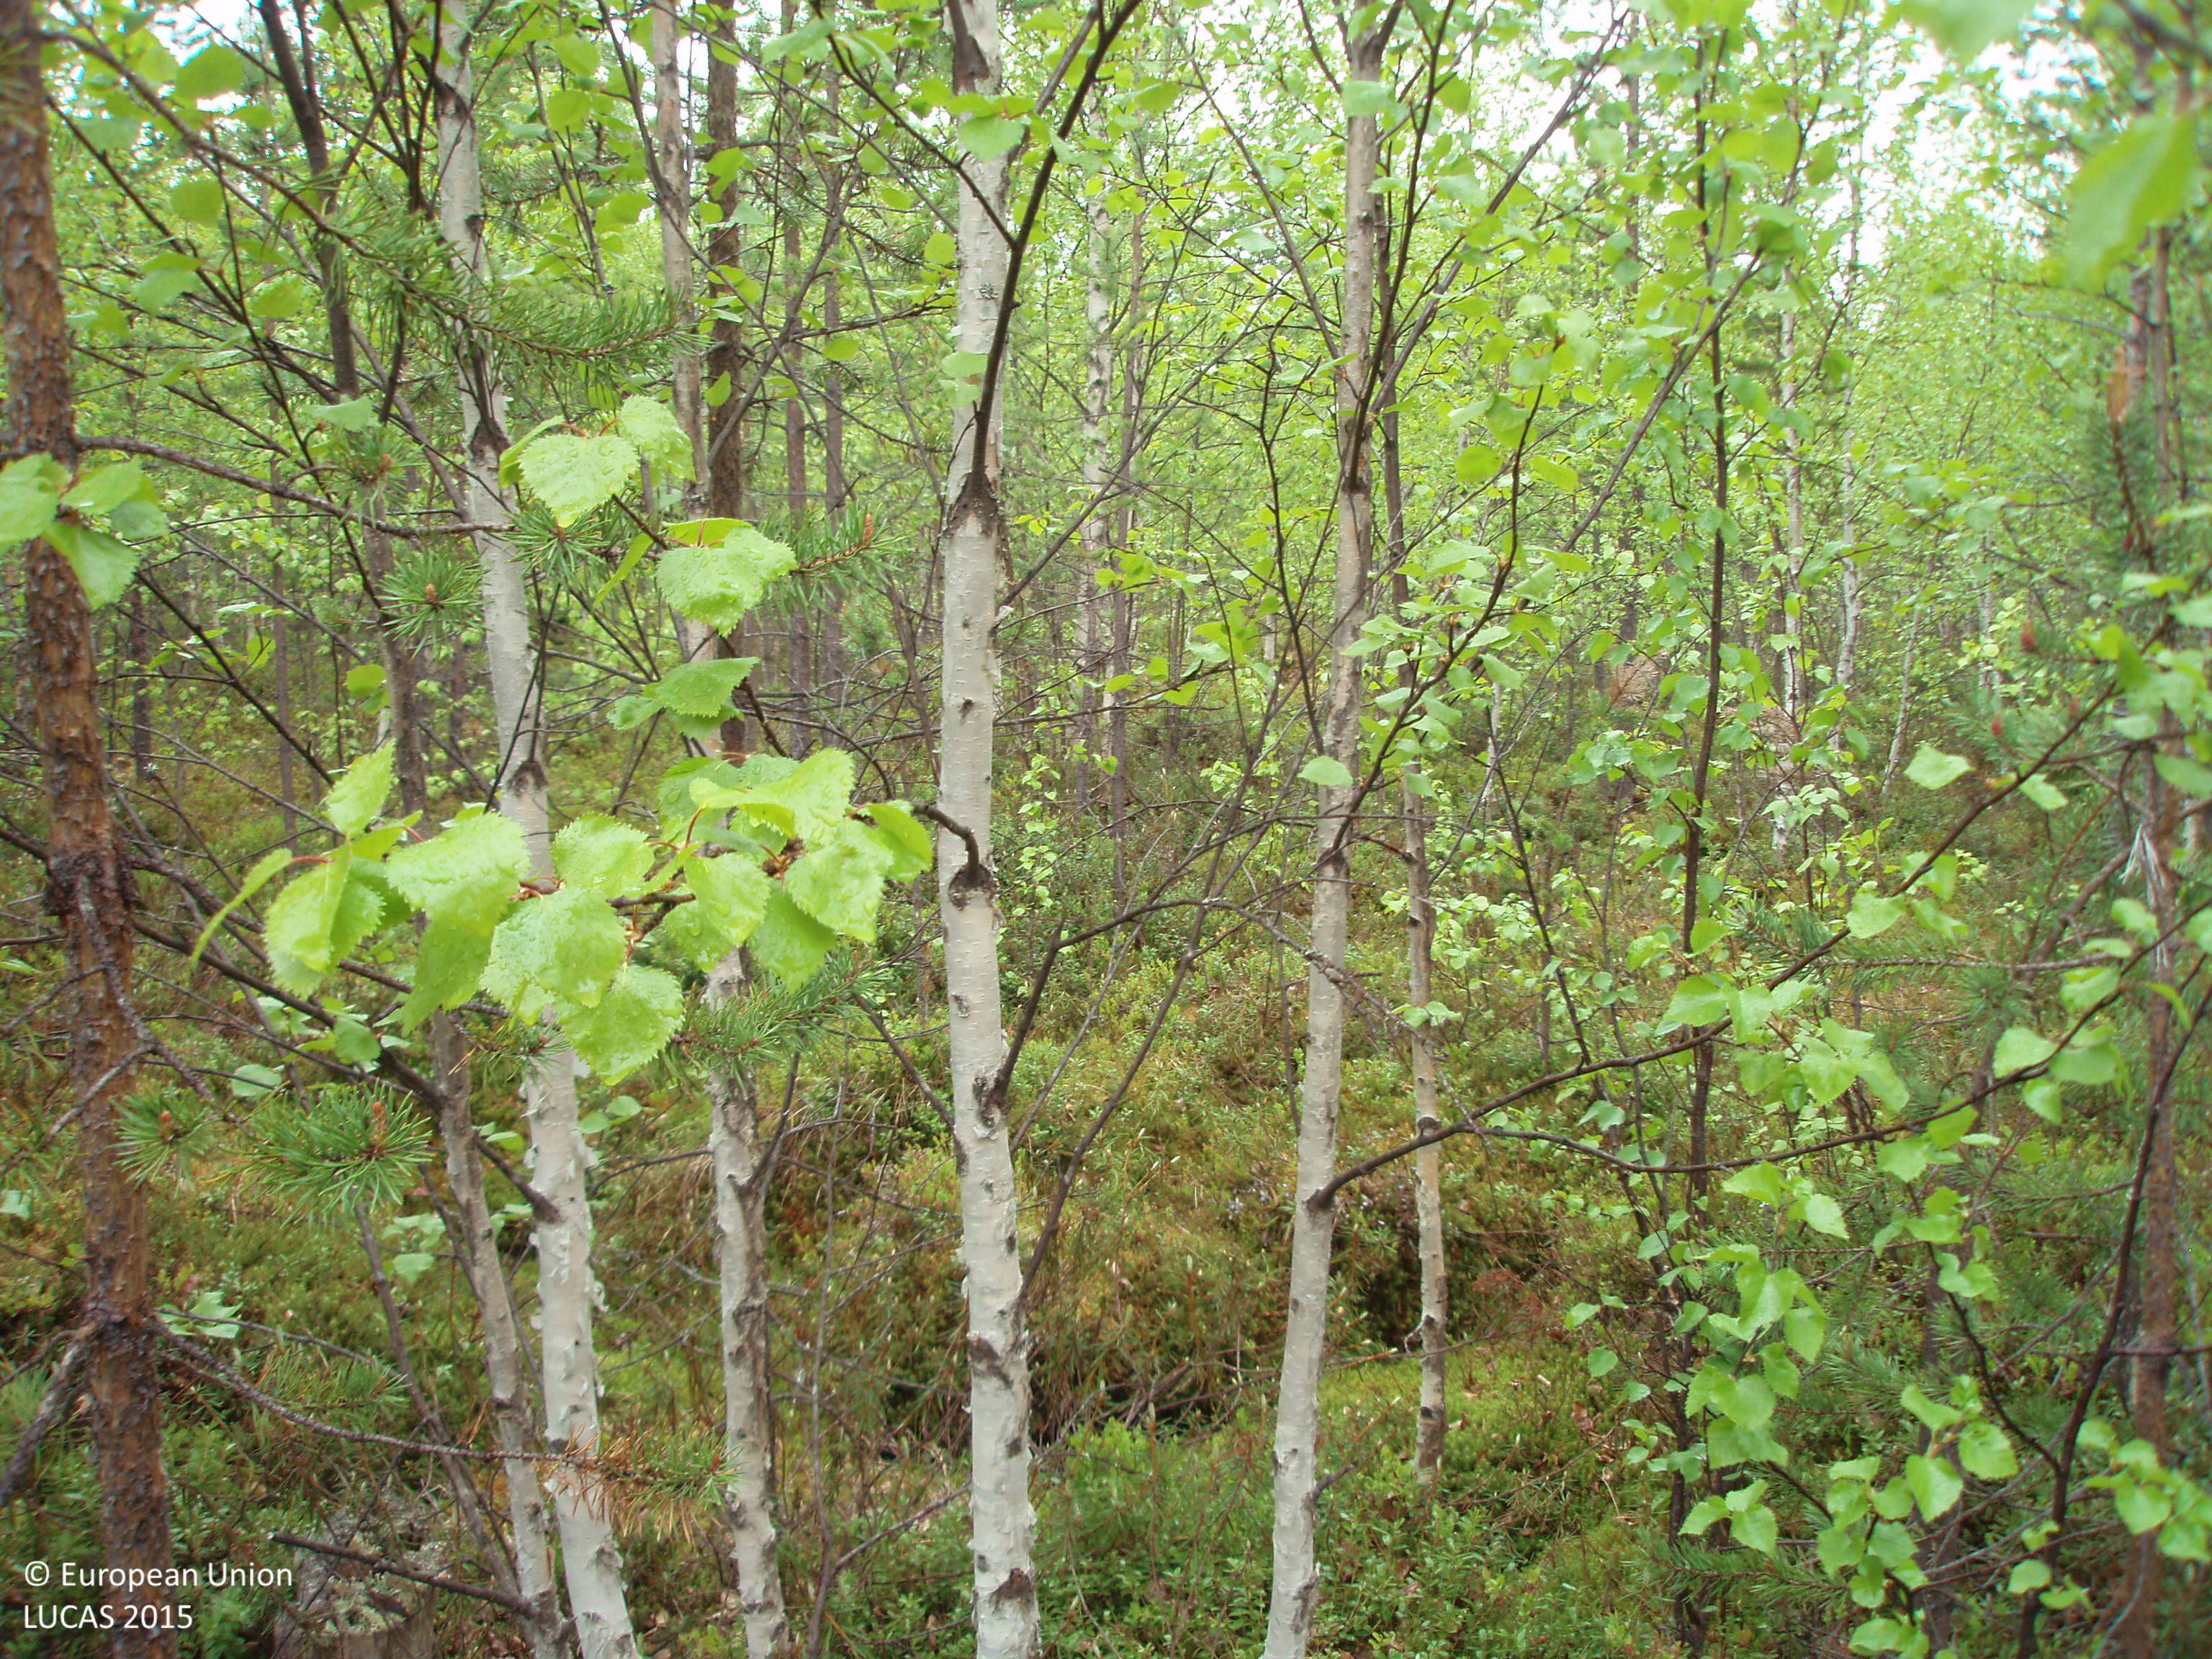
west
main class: Woodland
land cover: Pine dominated mixed woodland
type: boreal forest
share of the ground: > 75 %
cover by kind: broadleaved forest trees 70 %, coniferous forest trees 25 %, shrubs 5 %
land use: Forestry
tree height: > 5 m
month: June
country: FI
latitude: 67.3903
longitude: 26.6972
